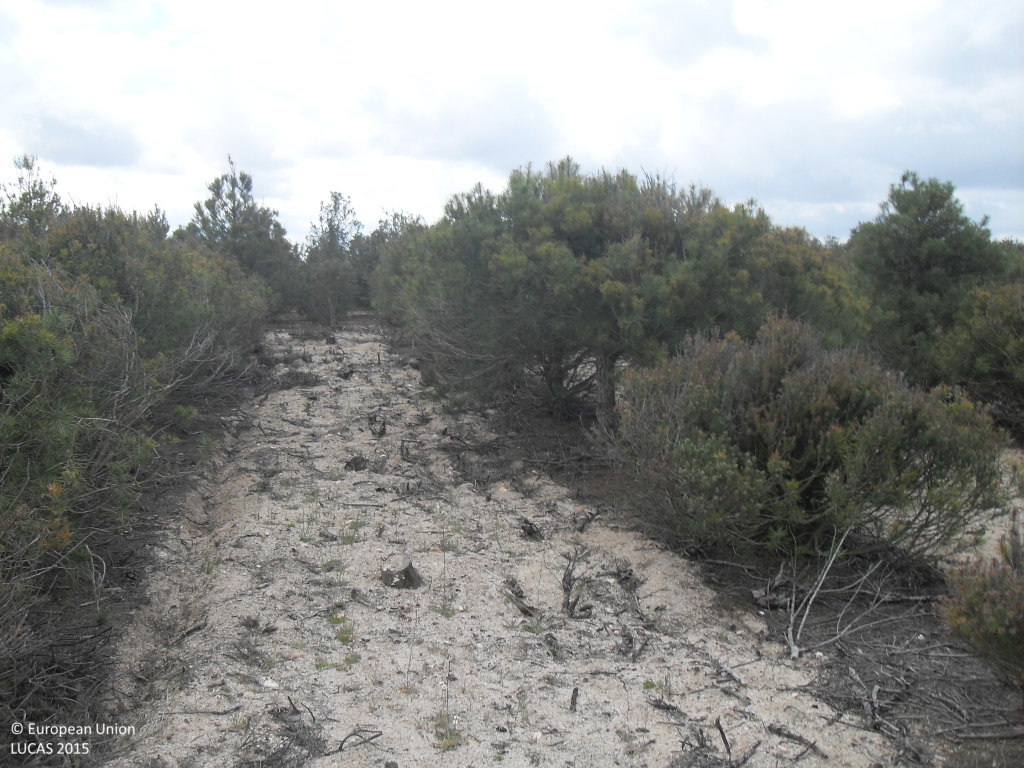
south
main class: Woodland
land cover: Pine dominated coniferous woodland
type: coniferous forest of the mediterranean region
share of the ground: > 75 %
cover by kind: coniferous forest trees 90 %, broadleaved forest trees 10 %
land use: Forestry
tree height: < 5 m
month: April
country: ES
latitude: 40.7692
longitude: -5.2911
